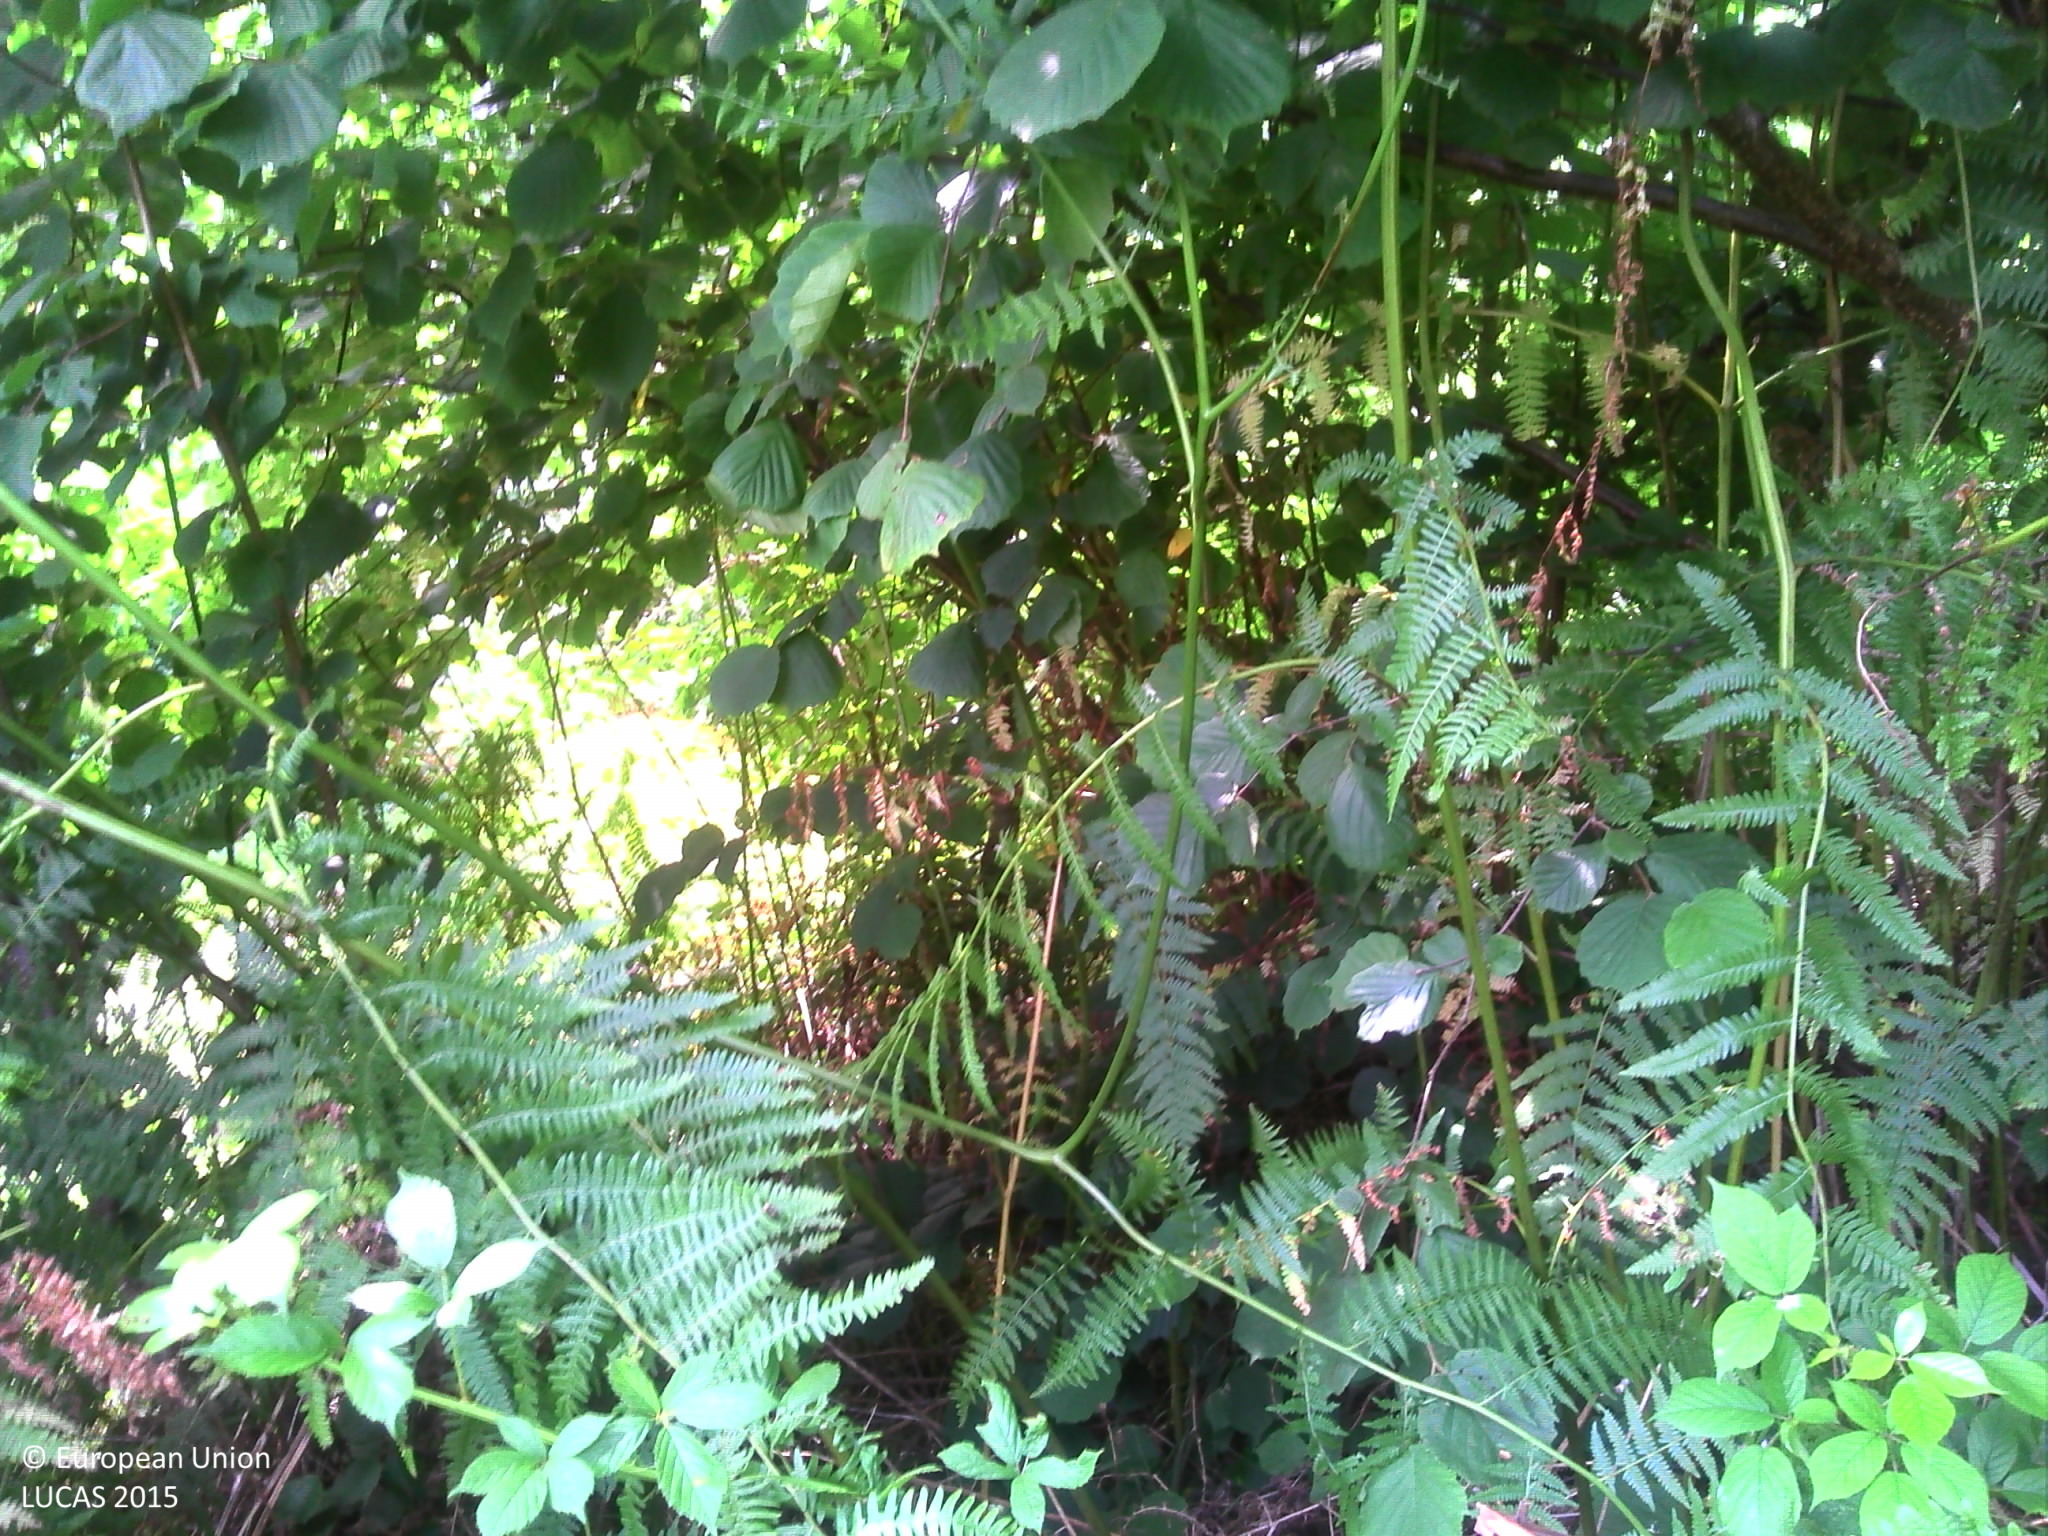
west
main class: Woodland
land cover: Spruce dominated mixed woodland
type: hemiboreal forest and nemoral coniferous forest and mixed broadleaved-coniferous forest
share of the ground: > 75 %
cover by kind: herbaceous plants 45 %, coniferous forest trees 20 %, unconsolidated bare surface 20 %, broadleaved forest trees 15 %
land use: Forestry
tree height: > 5 m
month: July
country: FR
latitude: 48.6388
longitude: -3.4181
